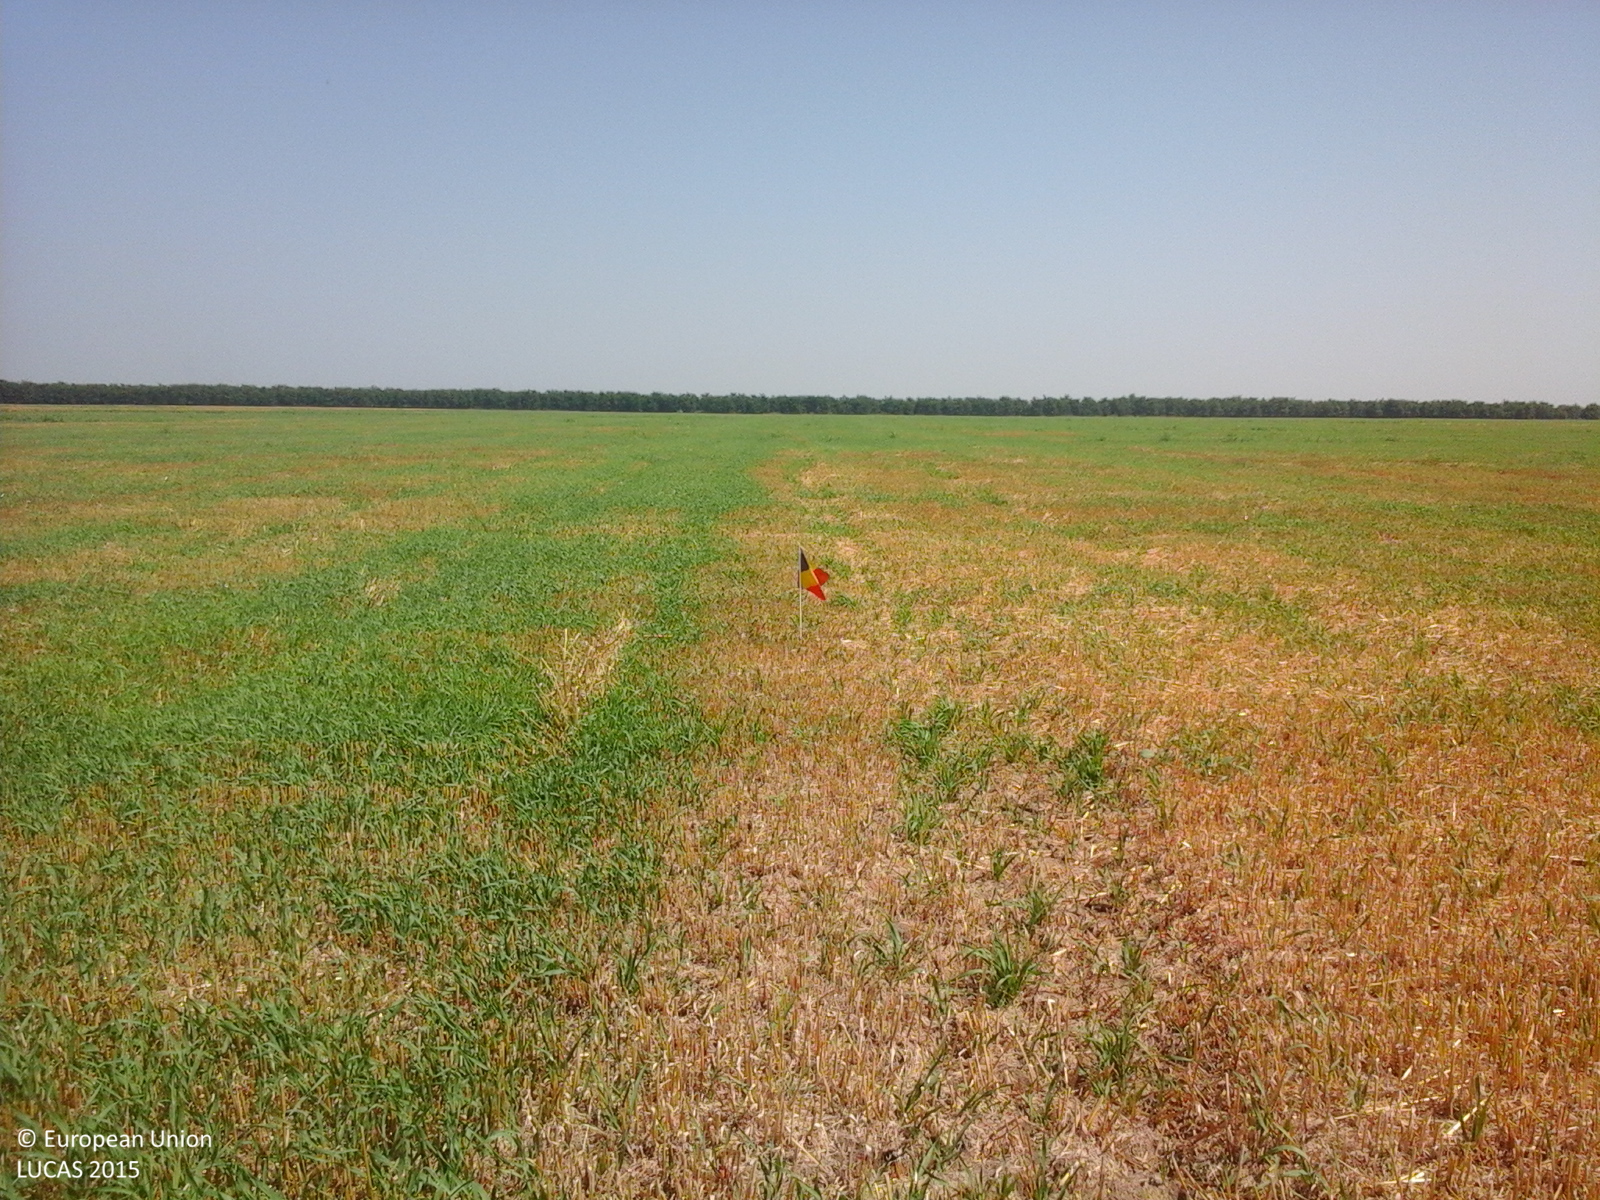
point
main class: Cropland
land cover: Durum wheat
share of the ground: > 75 %
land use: Agriculture (excluding fallow land and kitchen gardens)
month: July
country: RO
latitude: 44.5074
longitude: 27.2813
